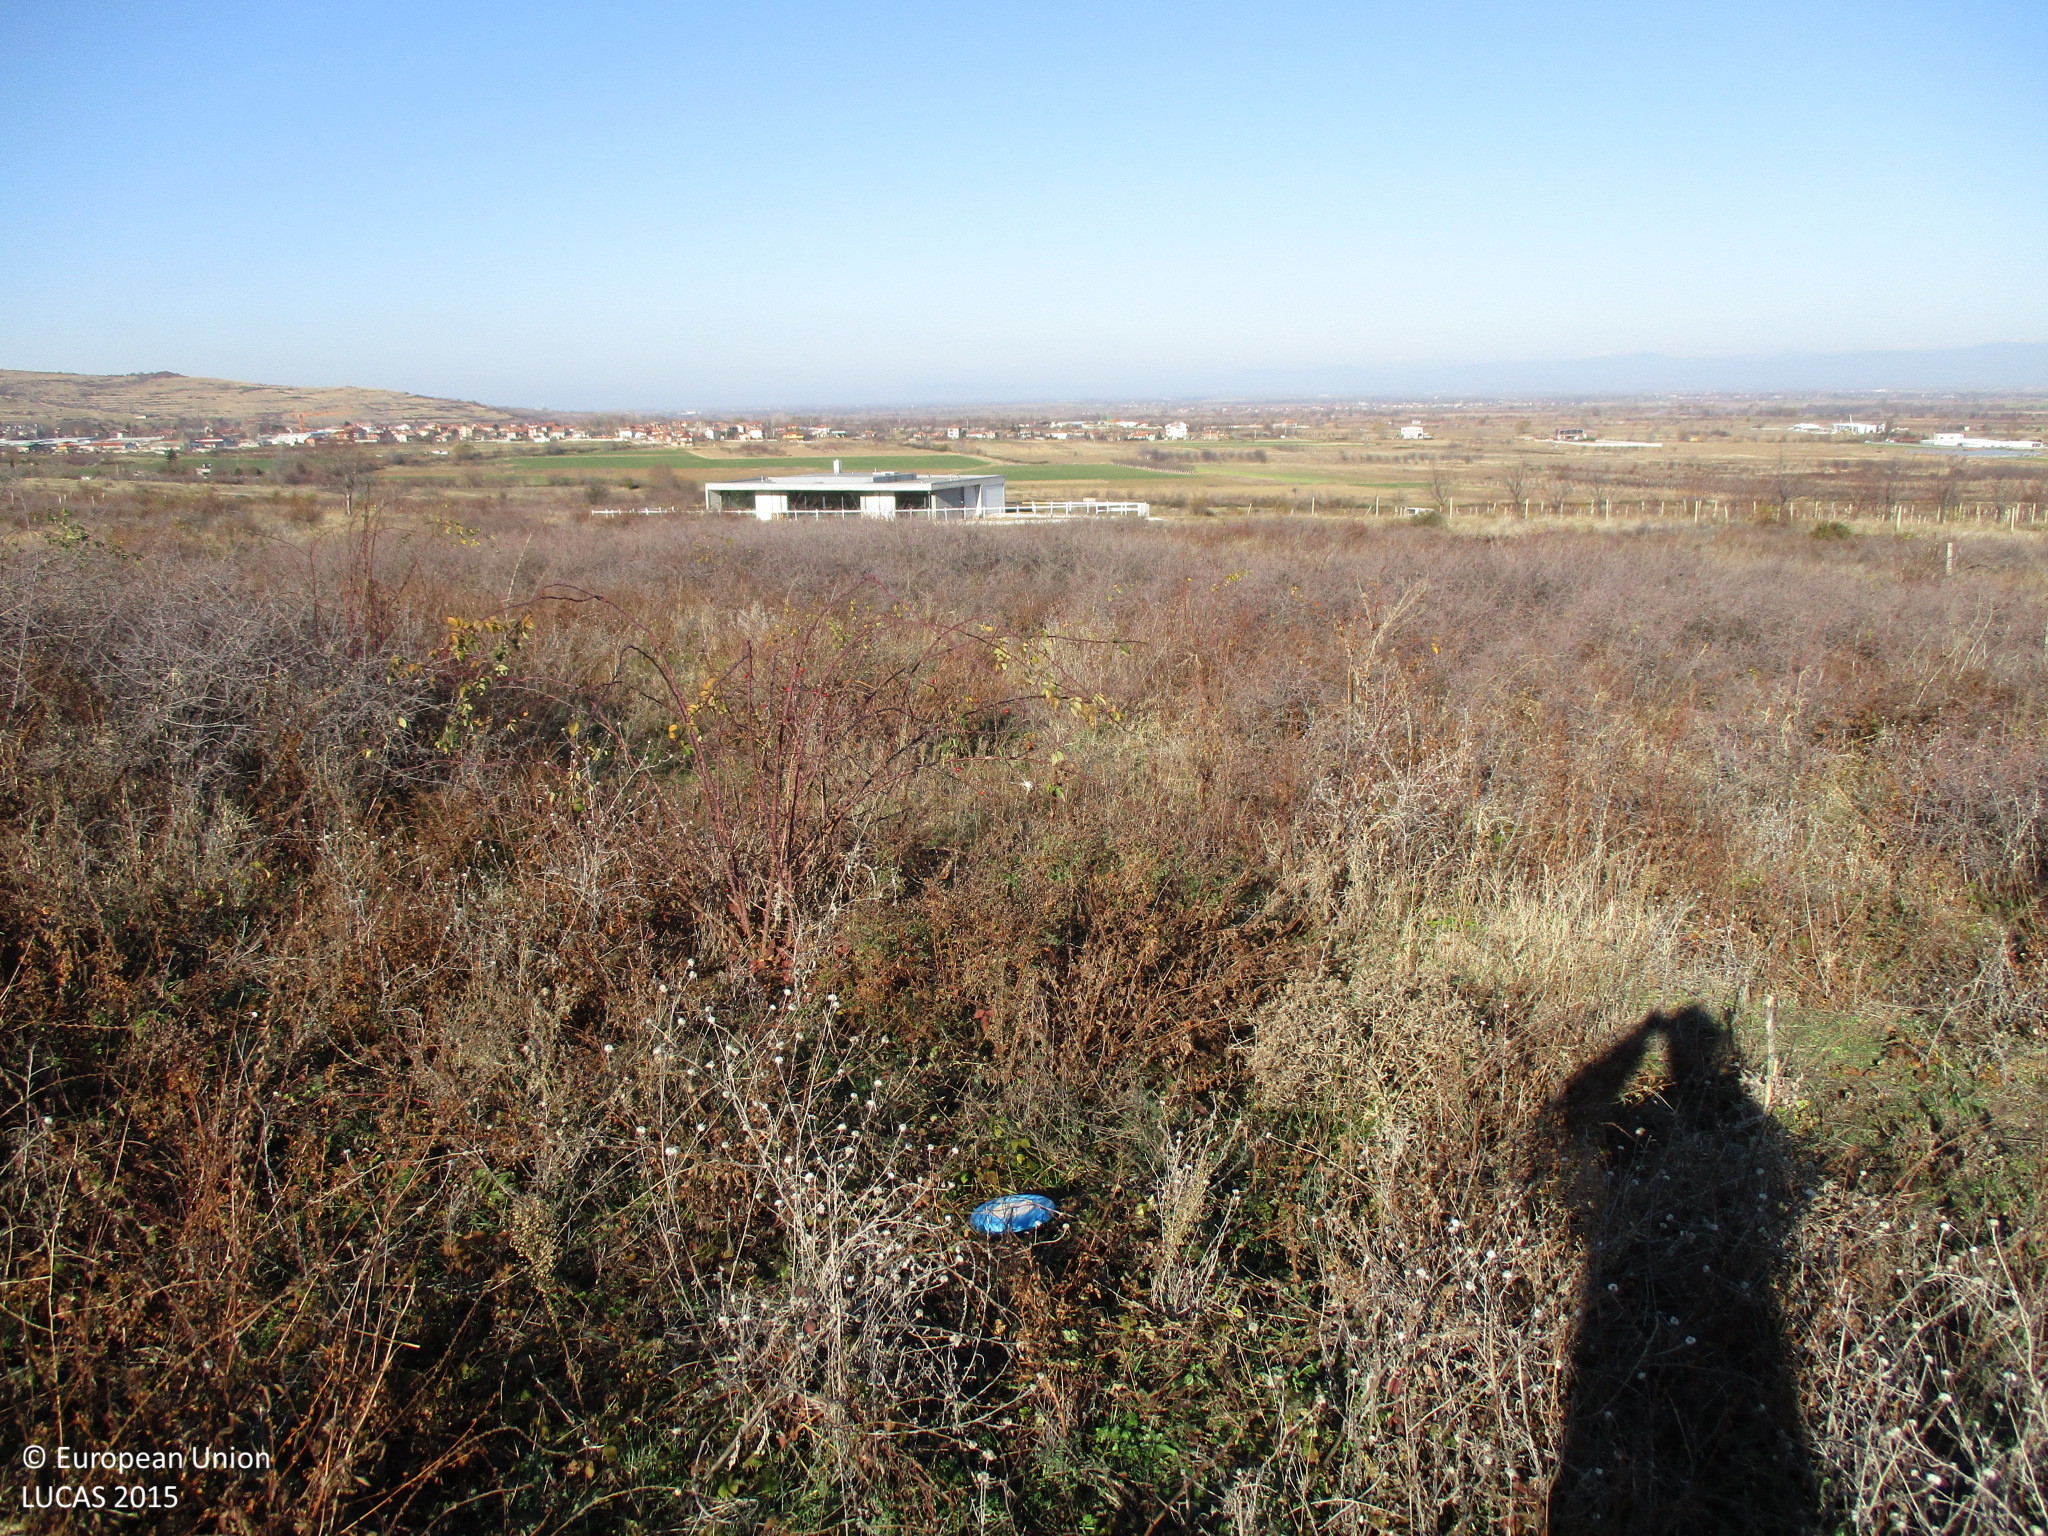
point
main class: Shrubland
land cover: Shrubland without tree cover
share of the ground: > 75 %
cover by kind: shrubs 70 %, herbaceous plants 30 %
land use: Semi-natural and natural areas not in use
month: December
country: BG
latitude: 42.0717
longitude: 24.6860
